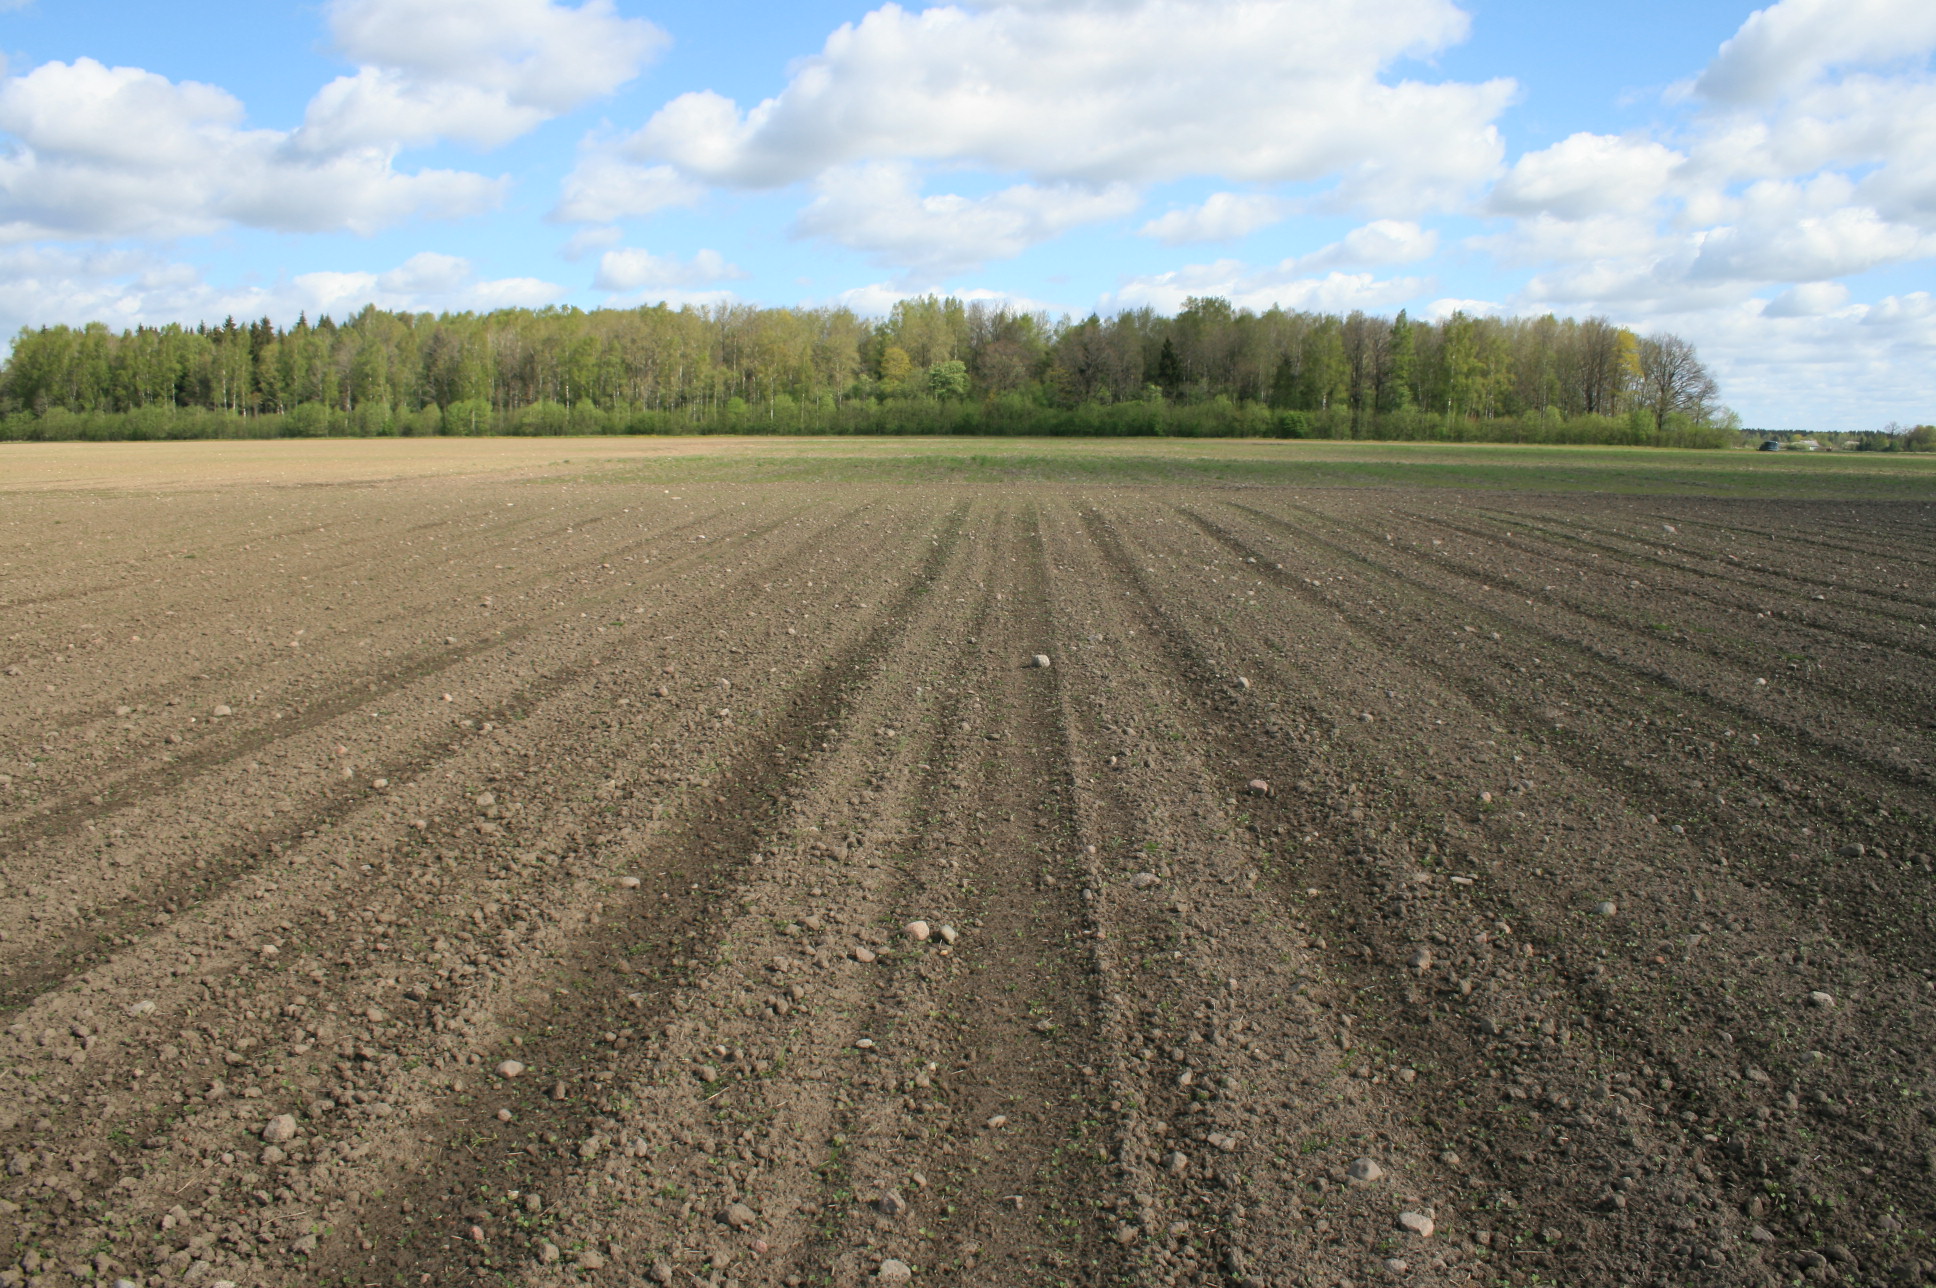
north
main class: Cropland
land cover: Dry pulses
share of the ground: < 10 %
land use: Agriculture (excluding fallow land and kitchen gardens)
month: May
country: LT
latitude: 56.2284
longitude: 21.5447
